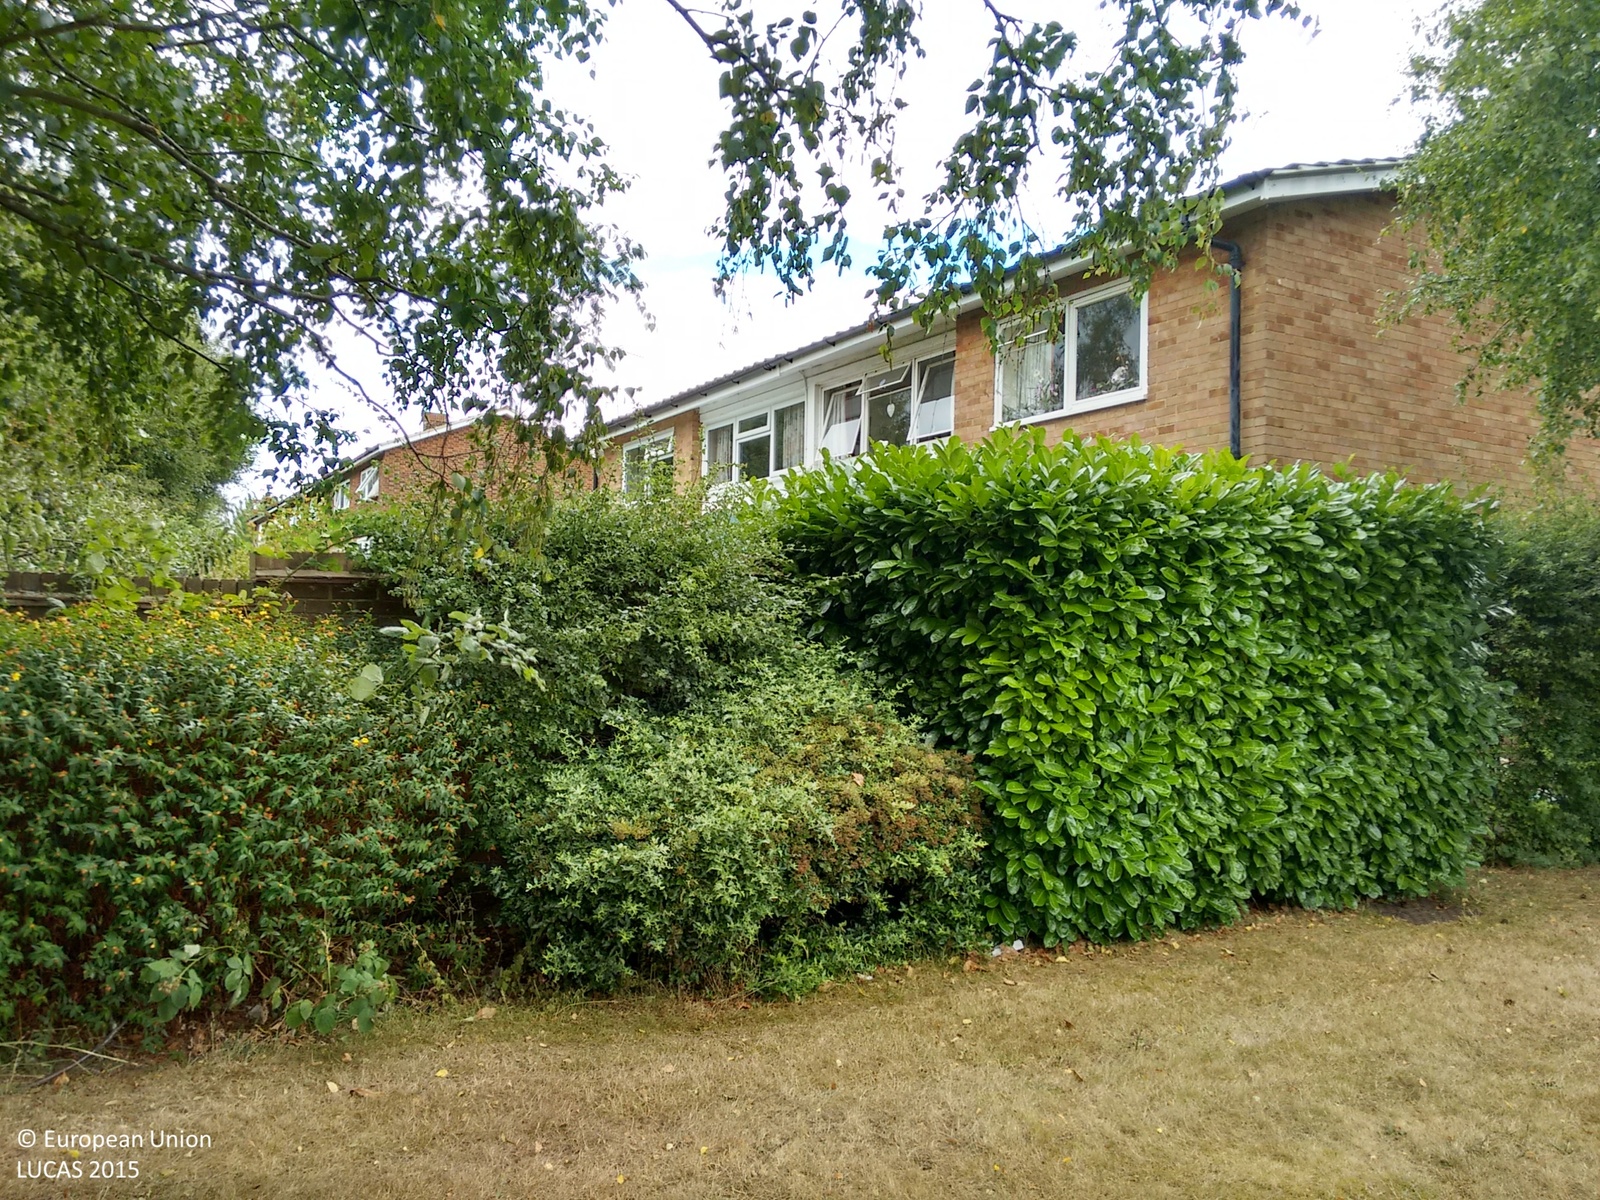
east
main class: Woodland
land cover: Broadleaved woodland
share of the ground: > 75 %
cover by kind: broadleaved forest trees 50 %, herbaceous plants 50 %
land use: Residential
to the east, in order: Broadleaved woodland; Artificial constructions in urban areas
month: July
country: GB
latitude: 51.4368
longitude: -0.3220
